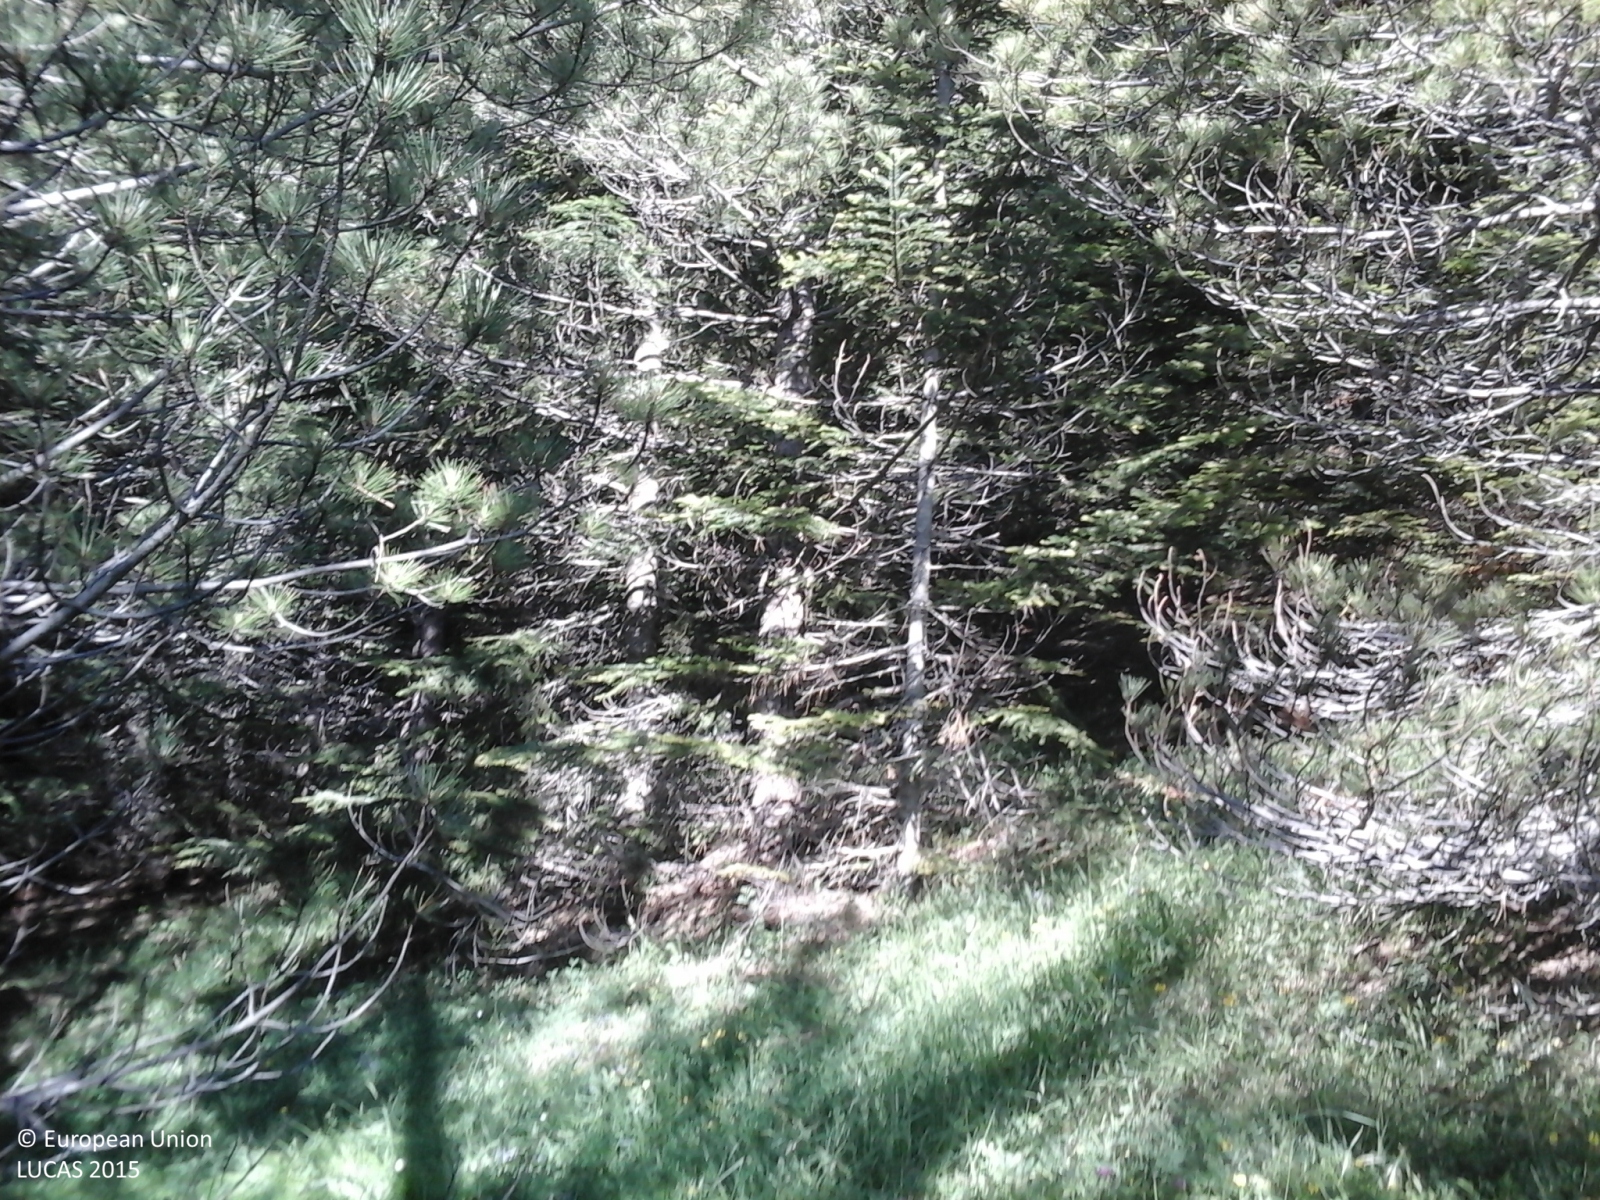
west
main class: Woodland
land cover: Other coniferous woodland
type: coniferous forest of the mediterranean region
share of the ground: > 75 %
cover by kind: coniferous forest trees 95 %, herbaceous plants 5 %
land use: Forestry
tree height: > 5 m
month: June
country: IT
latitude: 42.7480
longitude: 13.2035
